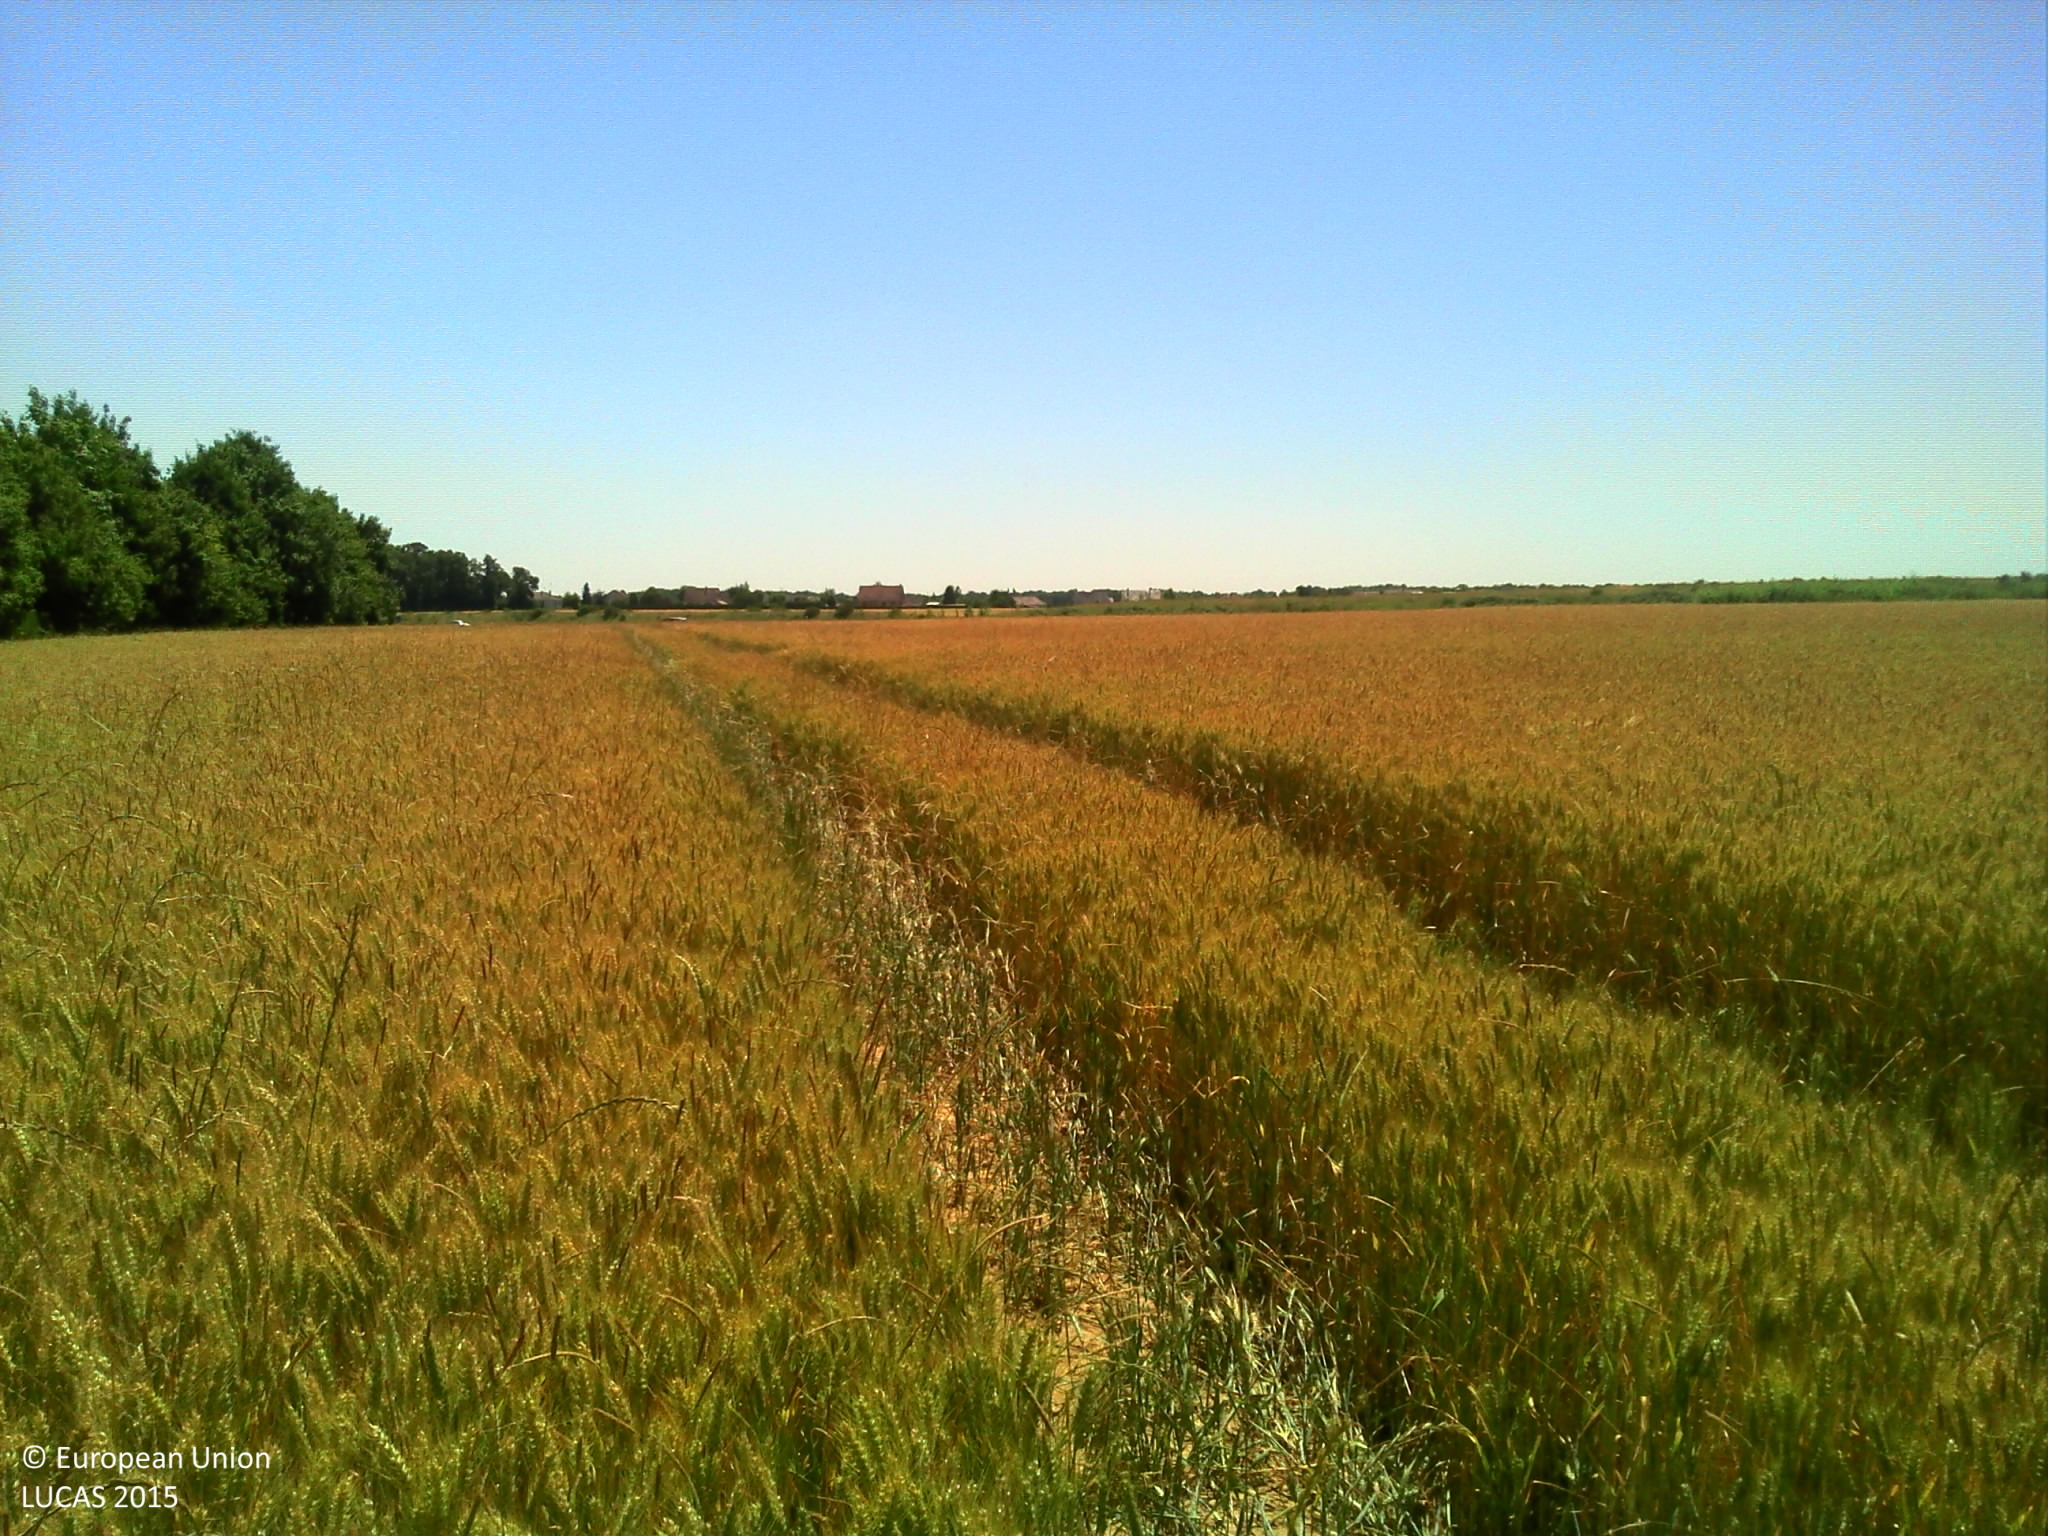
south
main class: Cropland
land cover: Common wheat
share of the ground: > 75 %
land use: Agriculture (excluding fallow land and kitchen gardens)
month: June
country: FR
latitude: 49.0395
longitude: 1.1010
